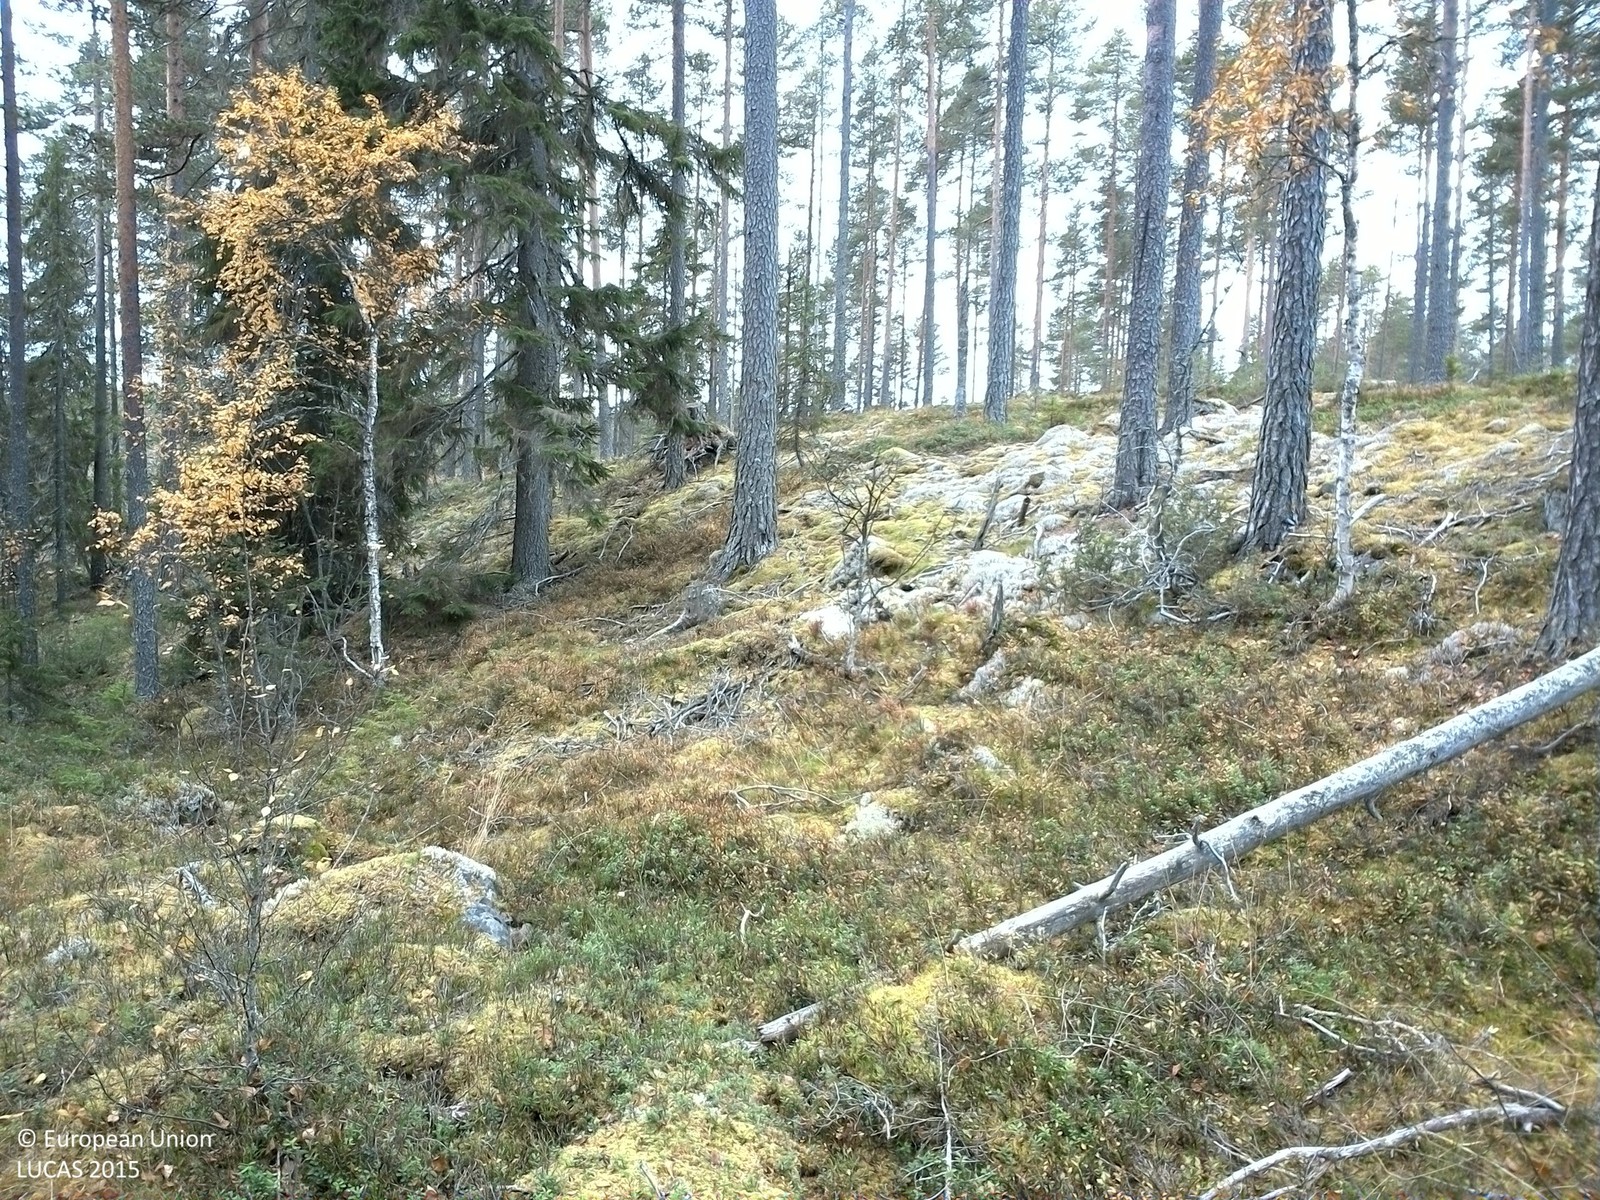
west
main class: Woodland
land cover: Pine dominated mixed woodland
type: boreal forest
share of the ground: 25 - 50 %
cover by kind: coniferous forest trees 35 %, shrubs 25 %, lichens and mosses 20 %, broadleaved forest trees 15 %, herbaceous plants 5 %
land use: Forestry
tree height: > 5 m
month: October
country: SE
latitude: 61.2135
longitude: 14.3610
